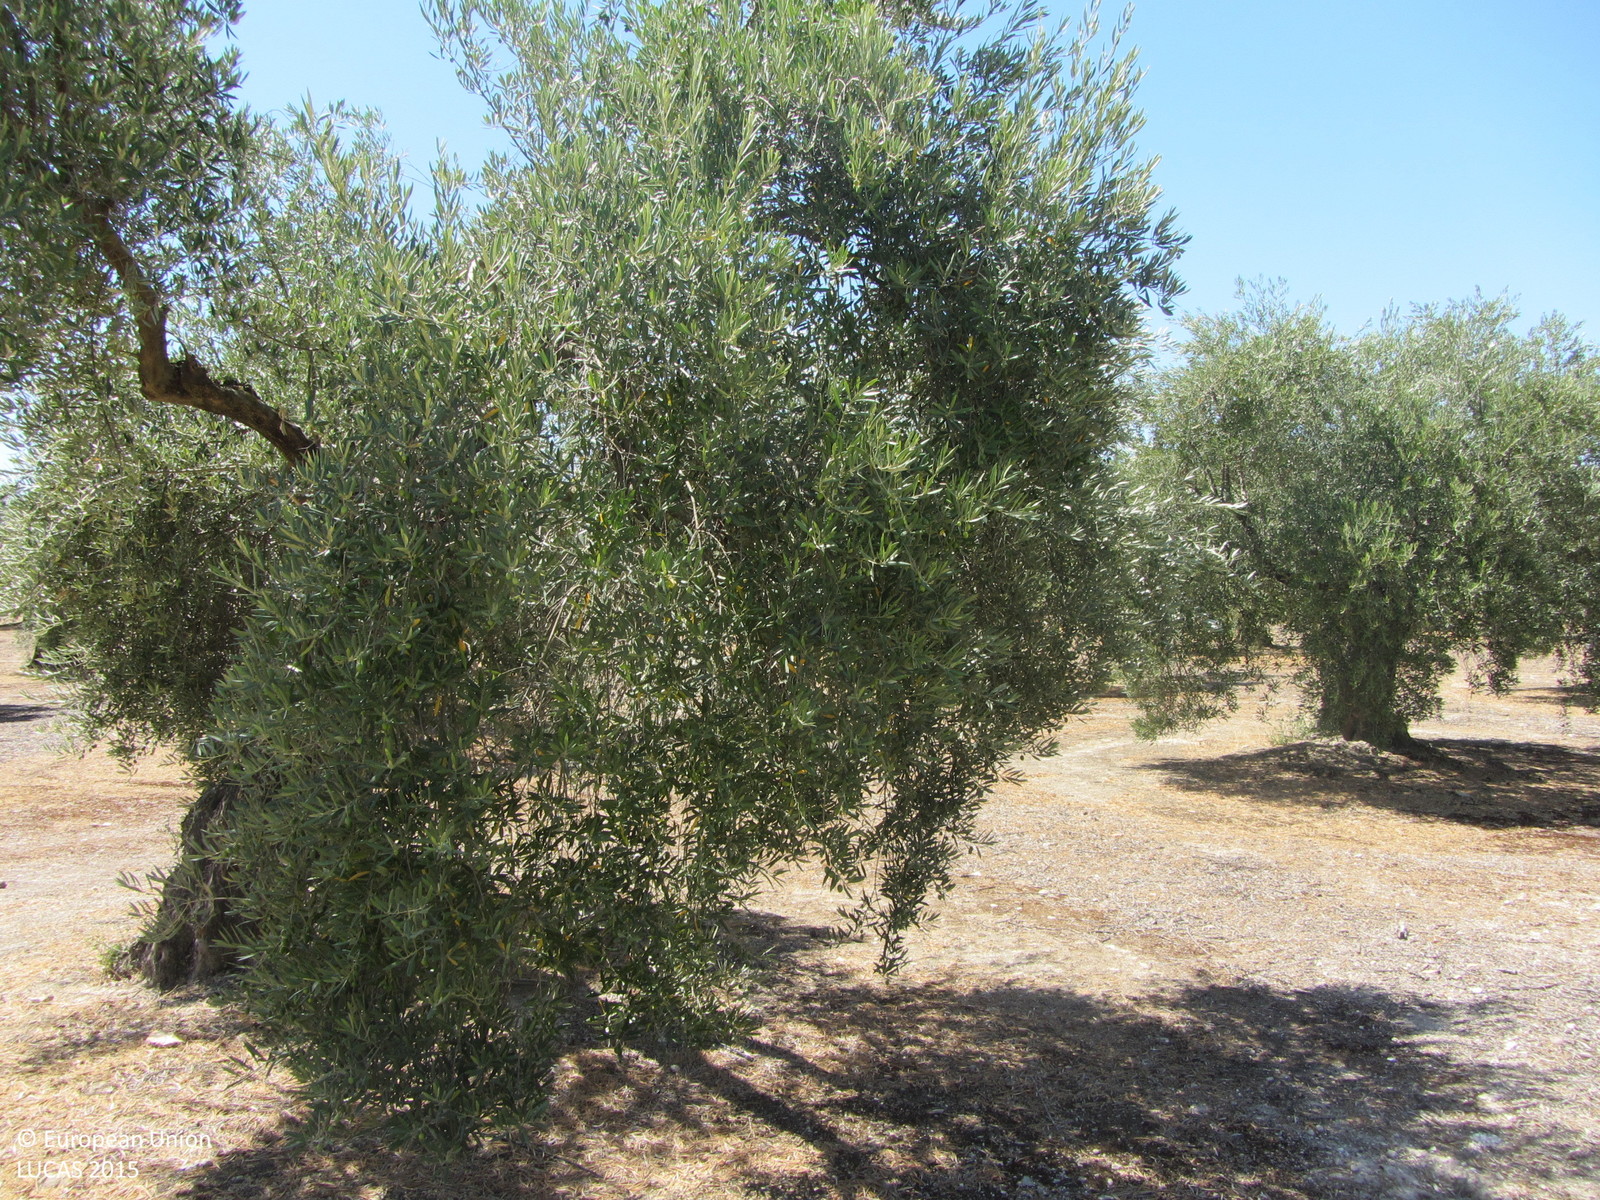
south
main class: Cropland
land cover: Olive groves
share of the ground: 25 - 50 %
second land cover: Other bare soil
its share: > 75 %
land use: Agriculture (excluding fallow land and kitchen gardens)
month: July
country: ES
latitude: 37.9972
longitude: -3.8405
